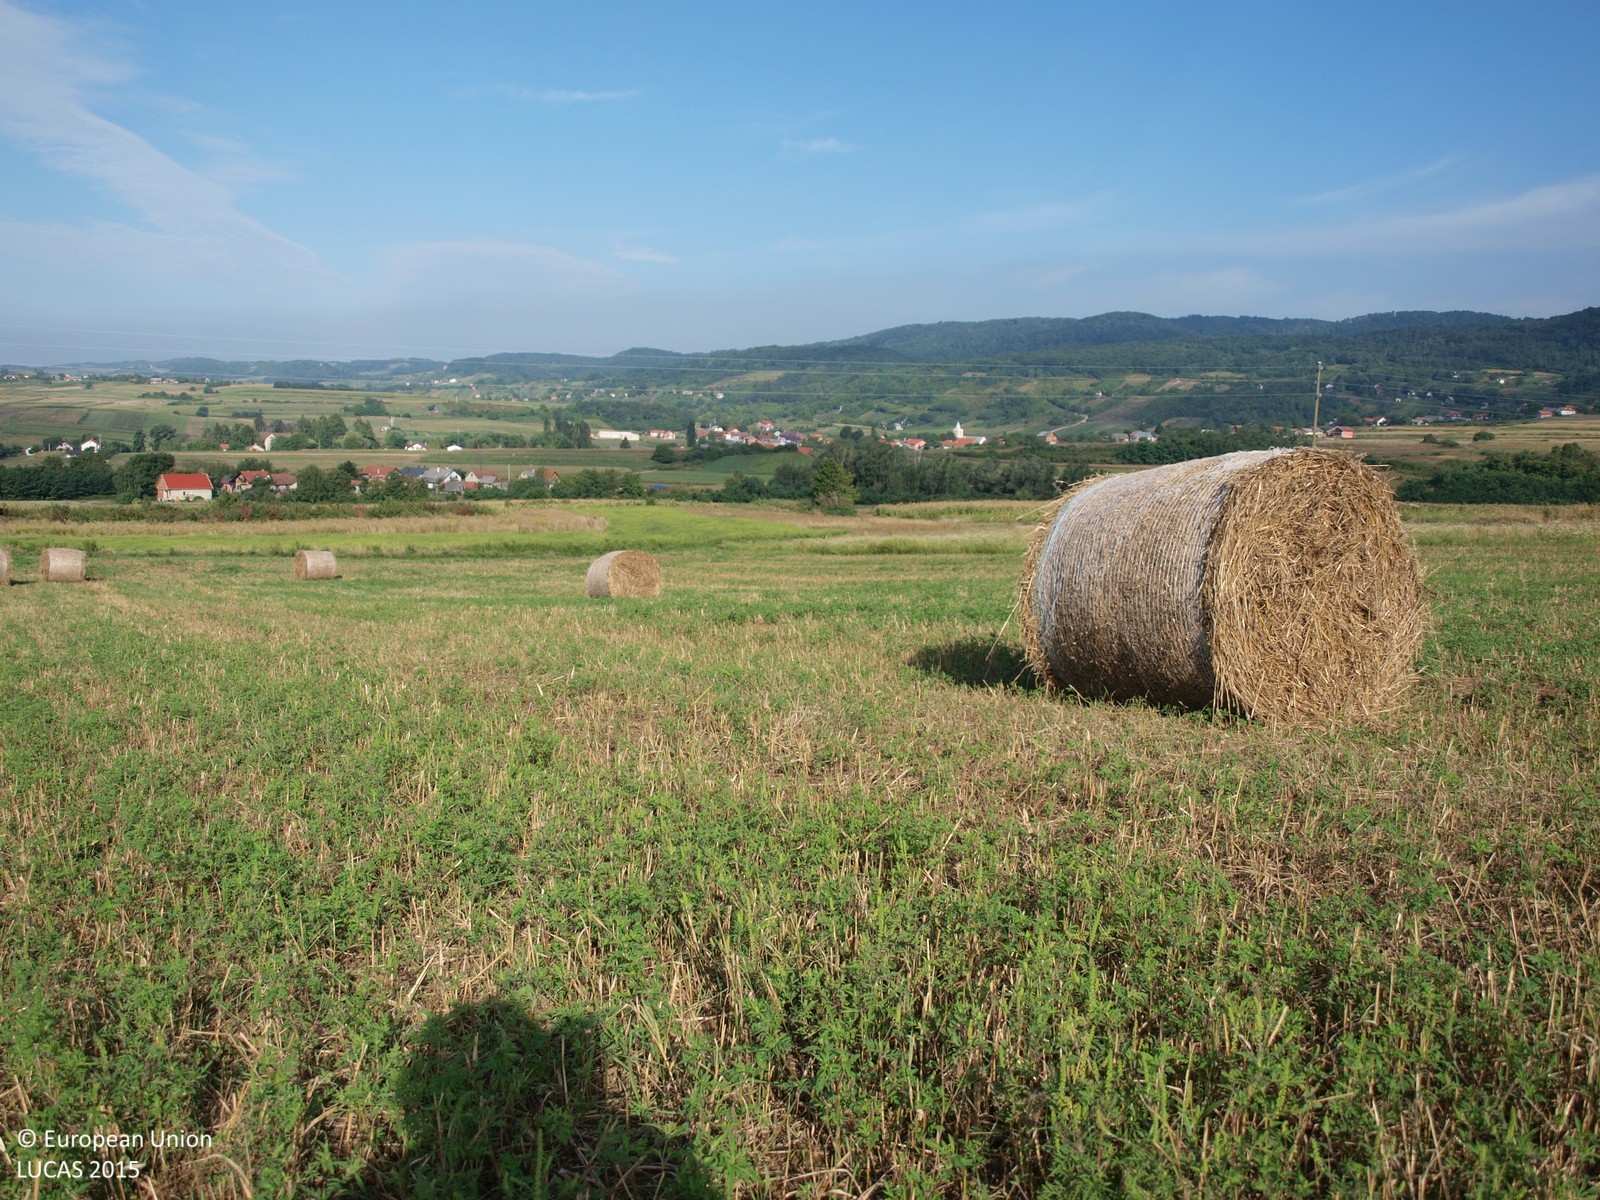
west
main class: Cropland
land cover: Oats
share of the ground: > 75 %
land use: Agriculture (excluding fallow land and kitchen gardens)
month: August
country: HR
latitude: 46.1051
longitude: 16.4035
